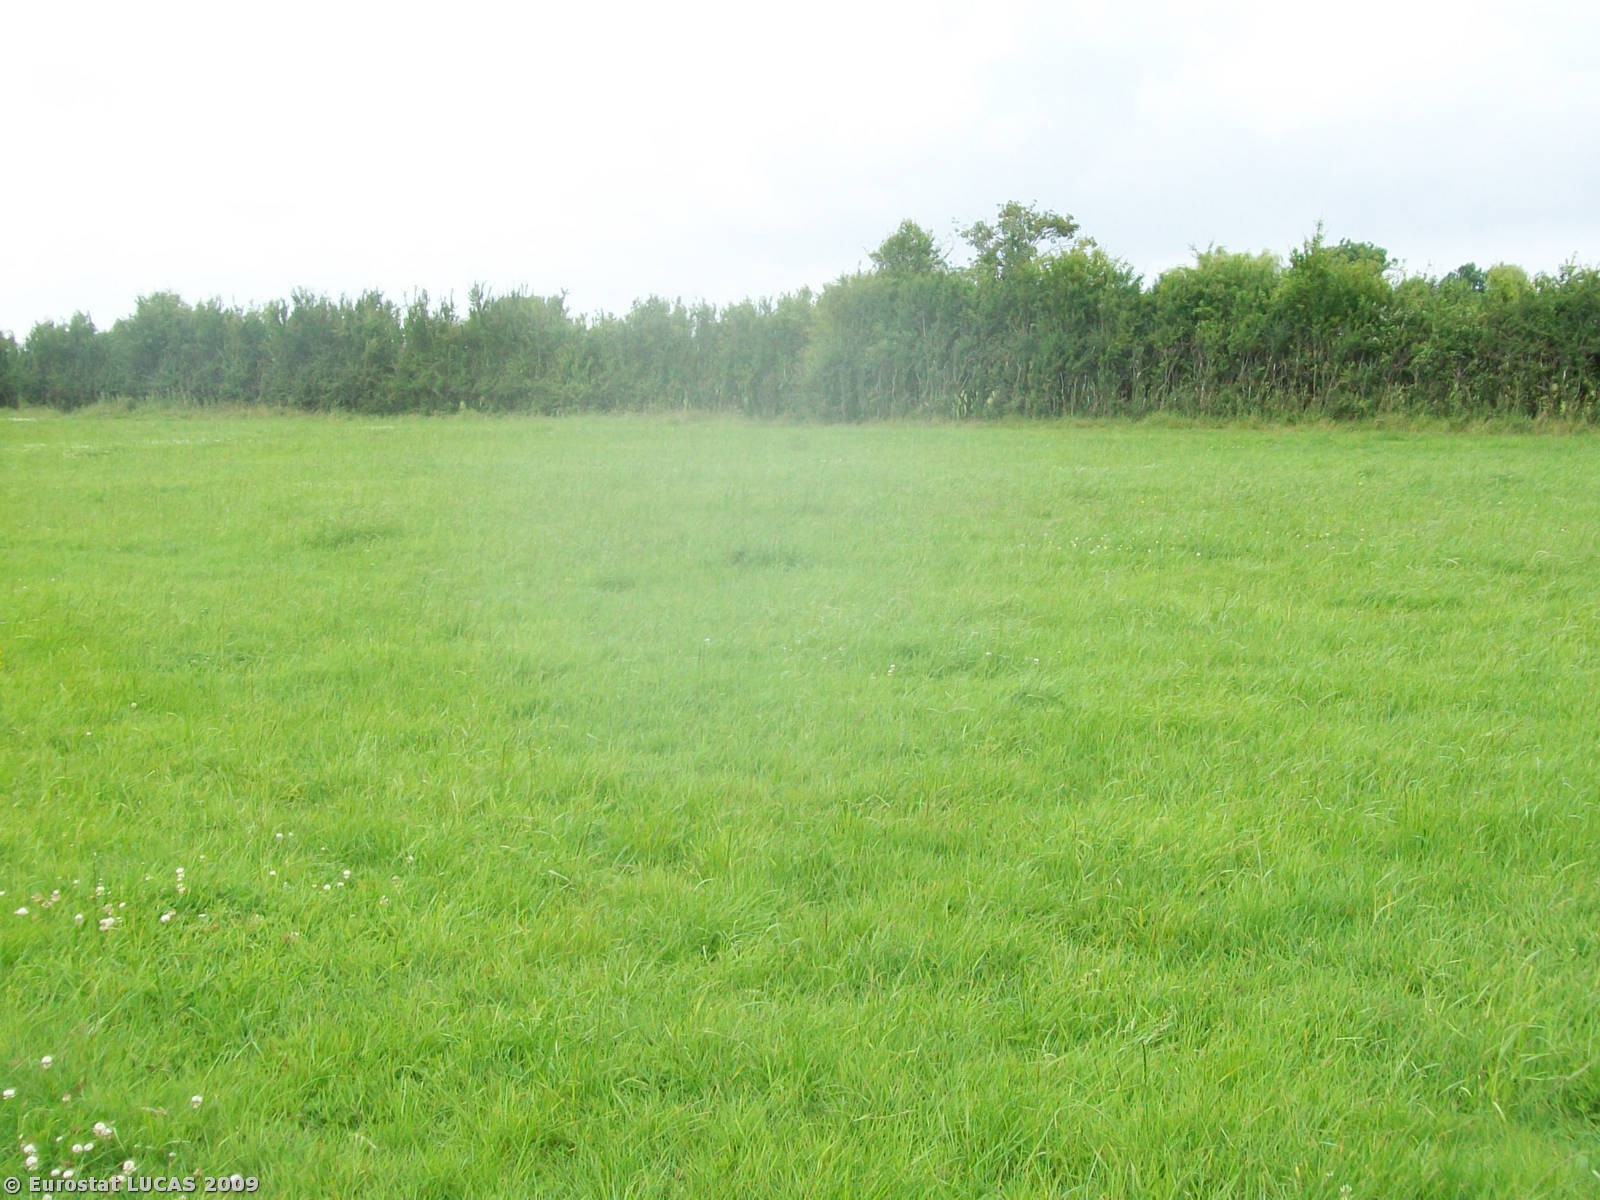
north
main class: Grassland
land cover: Grassland without tree/shrub cover
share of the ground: > 75 %
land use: Agriculture (excluding fallow land and kitchen gardens)
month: July
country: GB
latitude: 51.0072
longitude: -2.7983
